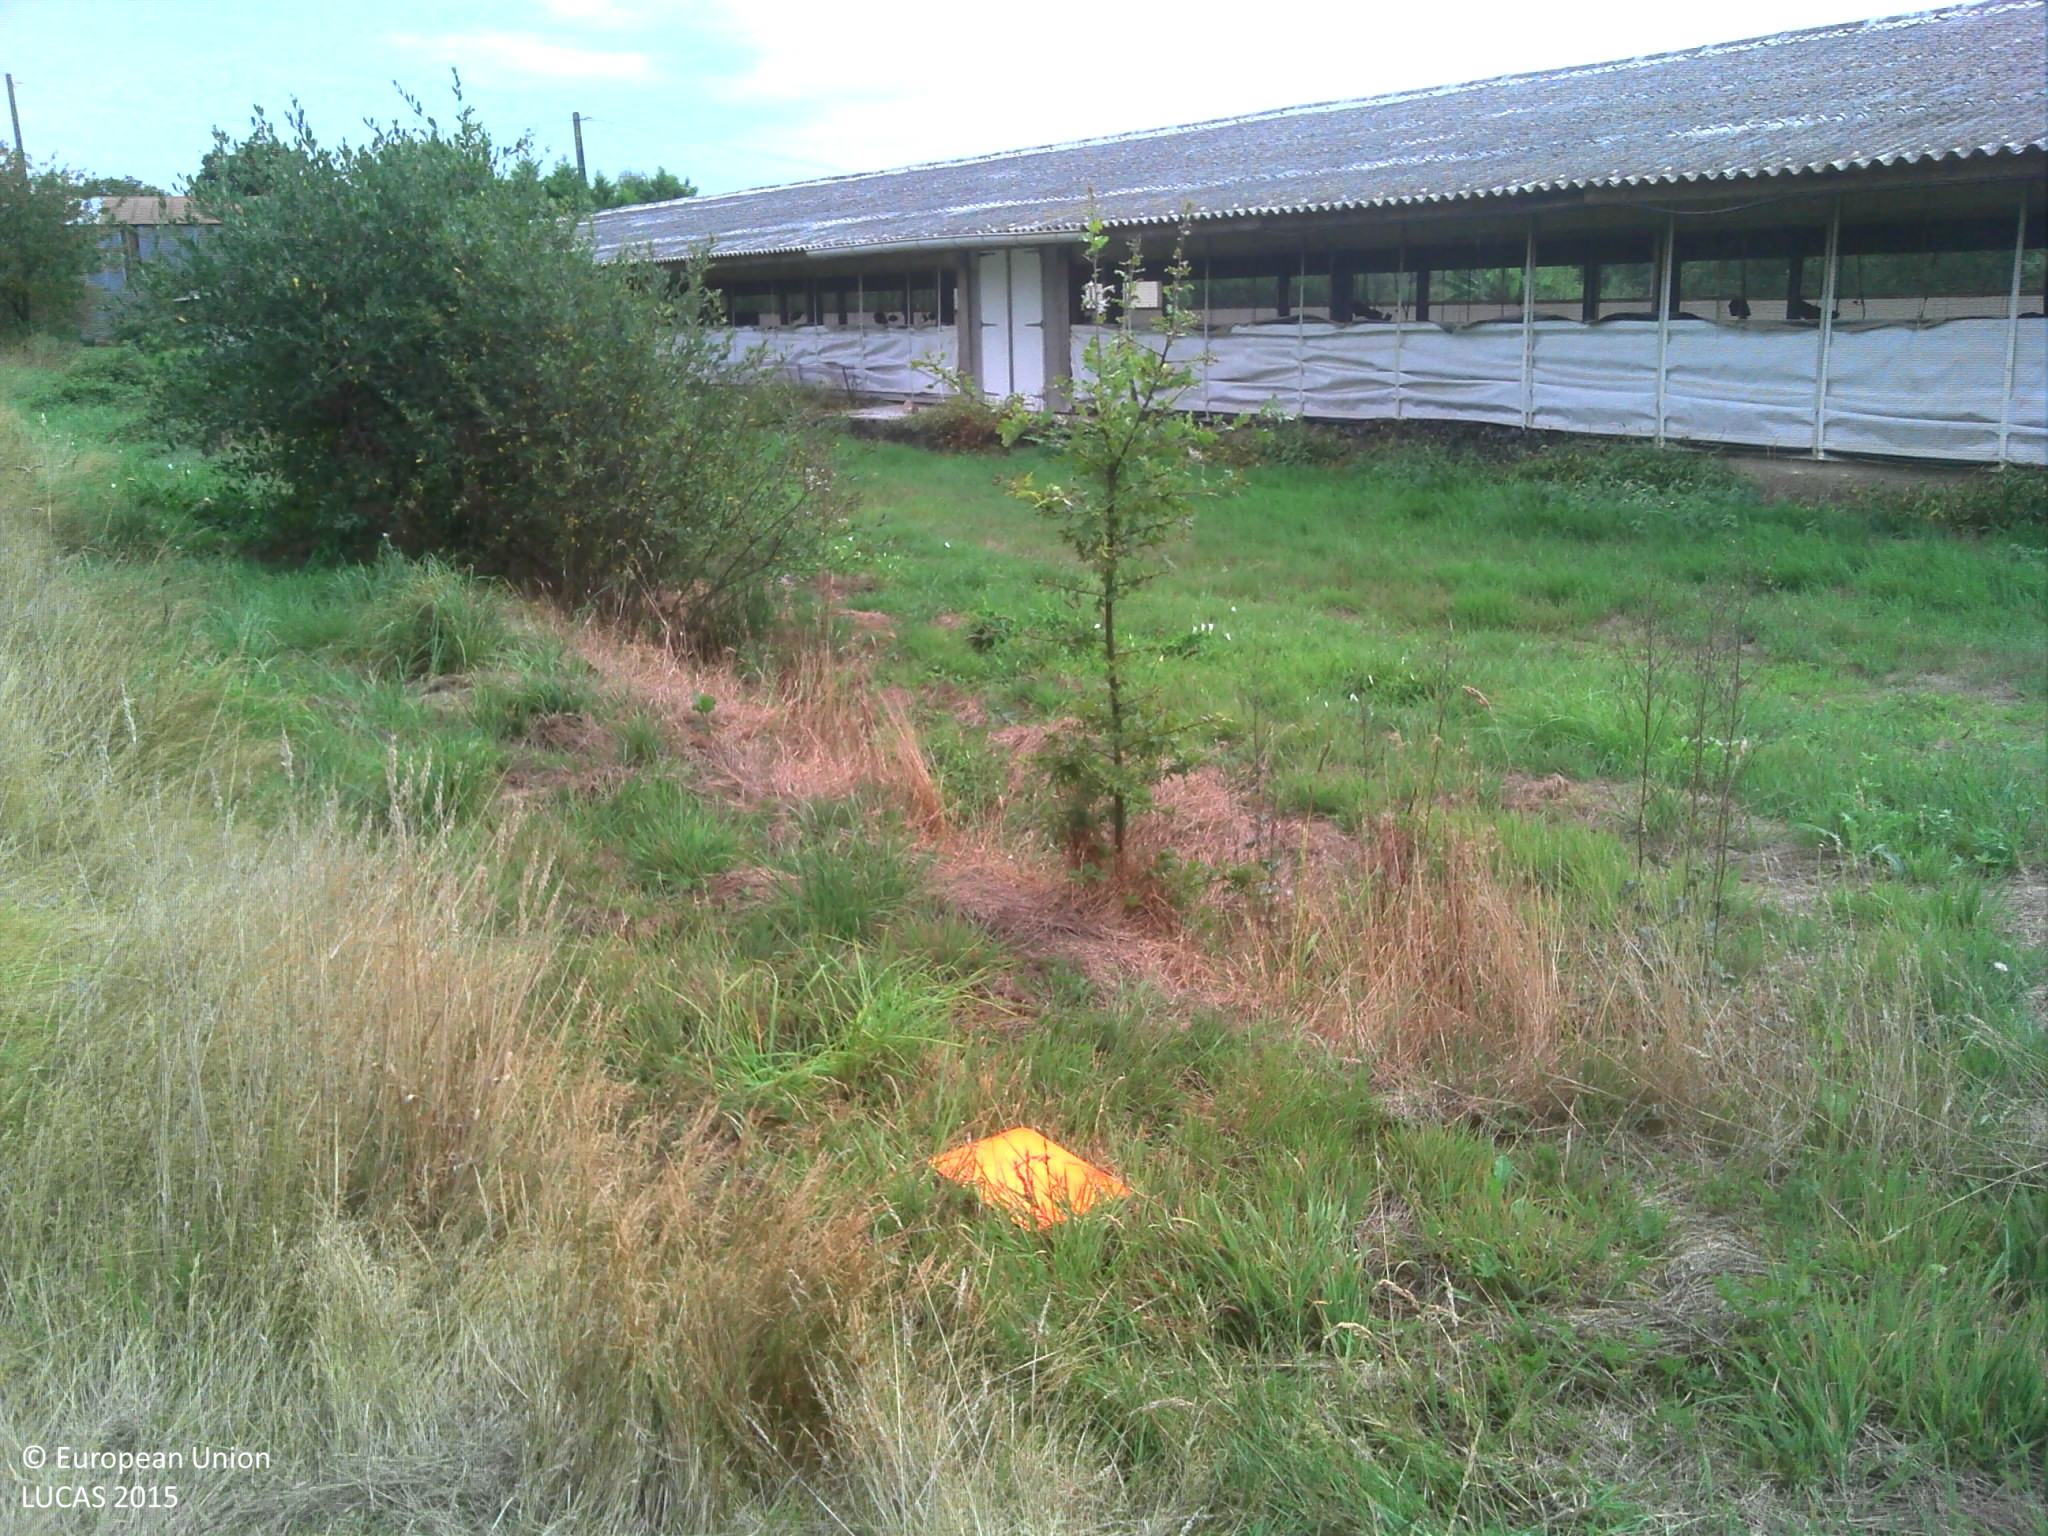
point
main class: Grassland
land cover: Grassland without tree/shrub cover
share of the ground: > 75 %
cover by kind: herbaceous plants 100 %
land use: Agriculture (excluding fallow land and kitchen gardens)
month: August
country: FR
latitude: 46.6571
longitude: -1.6580
